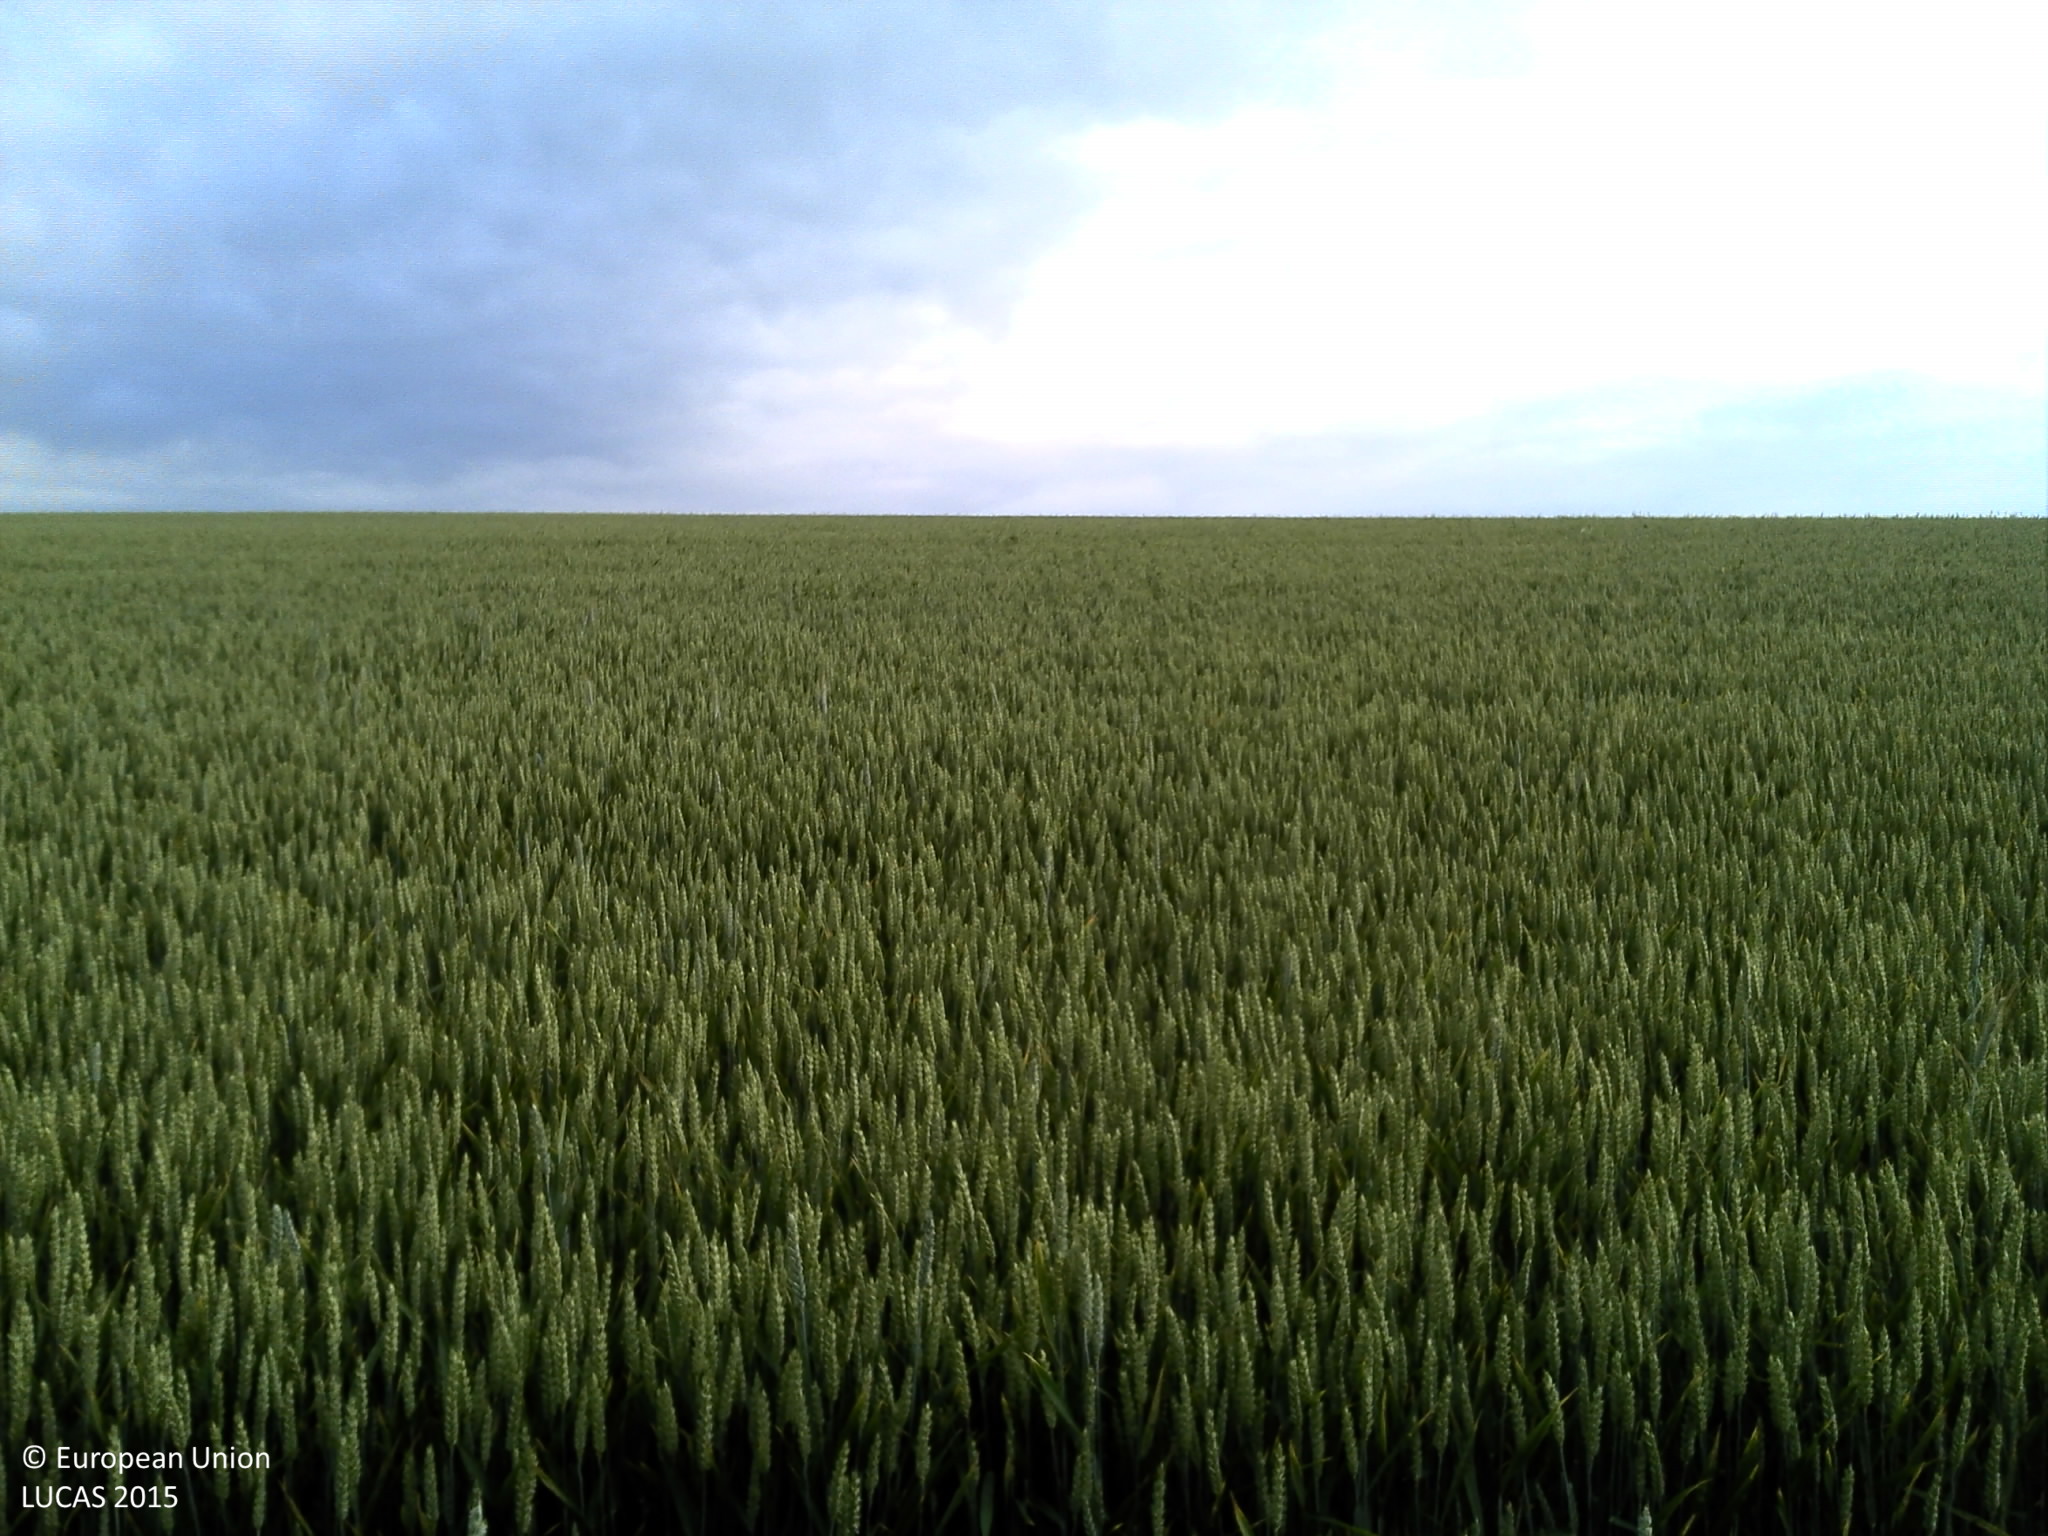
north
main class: Cropland
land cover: Common wheat
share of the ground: > 75 %
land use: Agriculture (excluding fallow land and kitchen gardens)
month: June
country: FR
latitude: 49.3754
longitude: 5.0808
